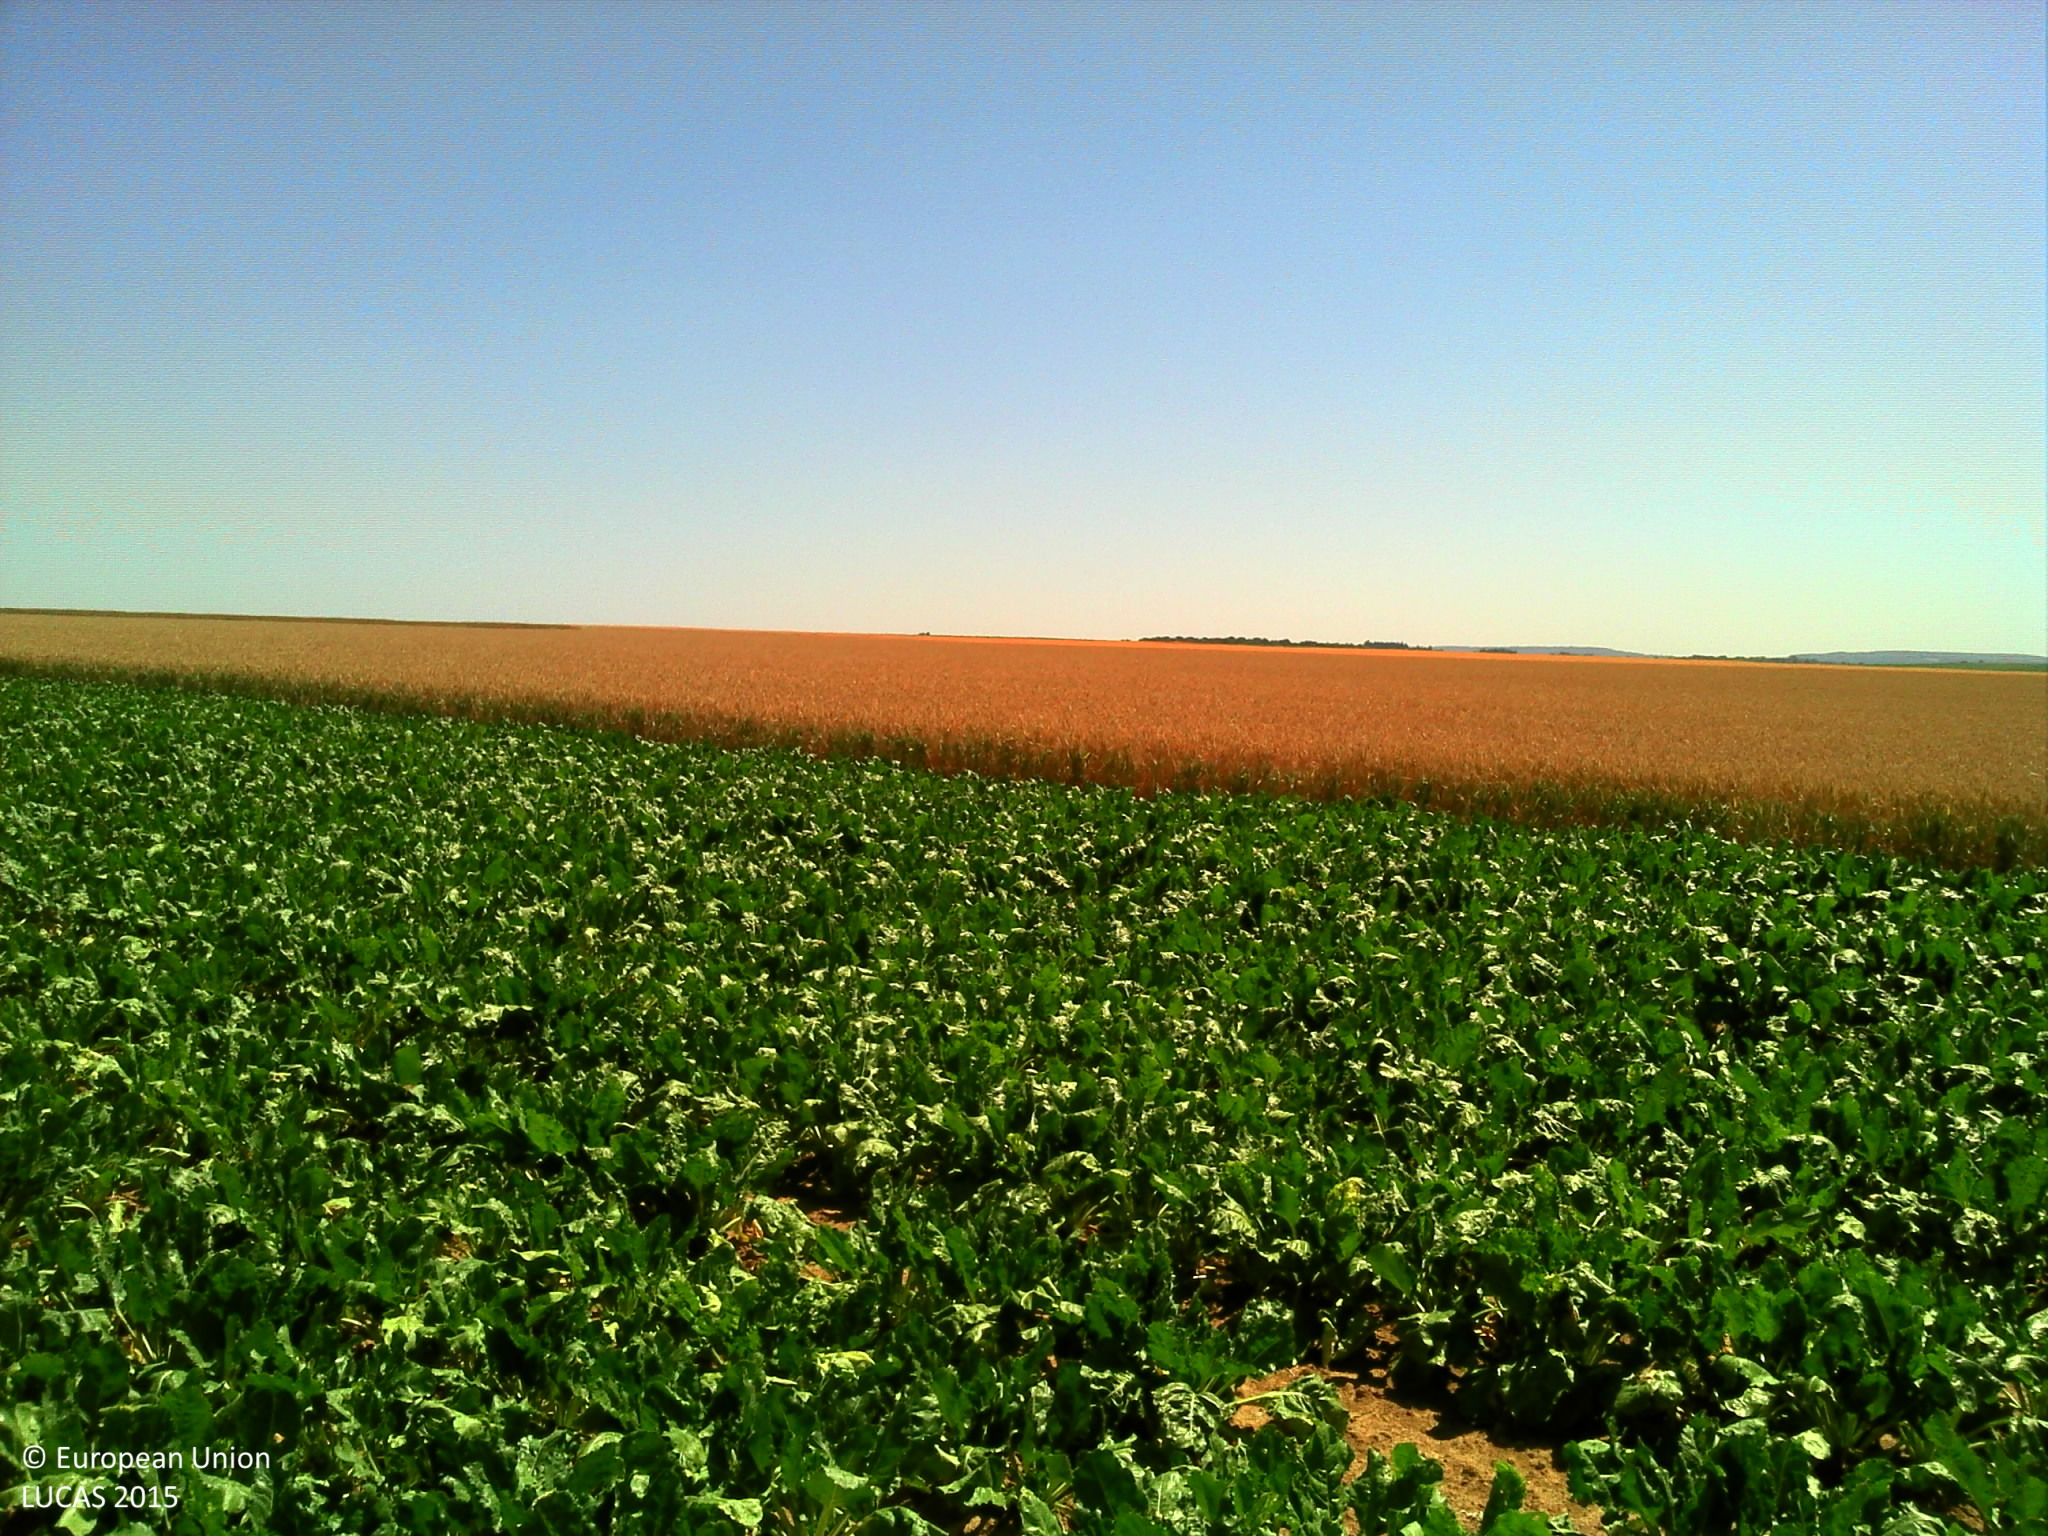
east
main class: Cropland
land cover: Sugar beet
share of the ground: > 75 %
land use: Agriculture (excluding fallow land and kitchen gardens)
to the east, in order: Sugar beet; Ditches and canals; Common wheat
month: July
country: FR
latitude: 49.2227
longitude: 1.8422
